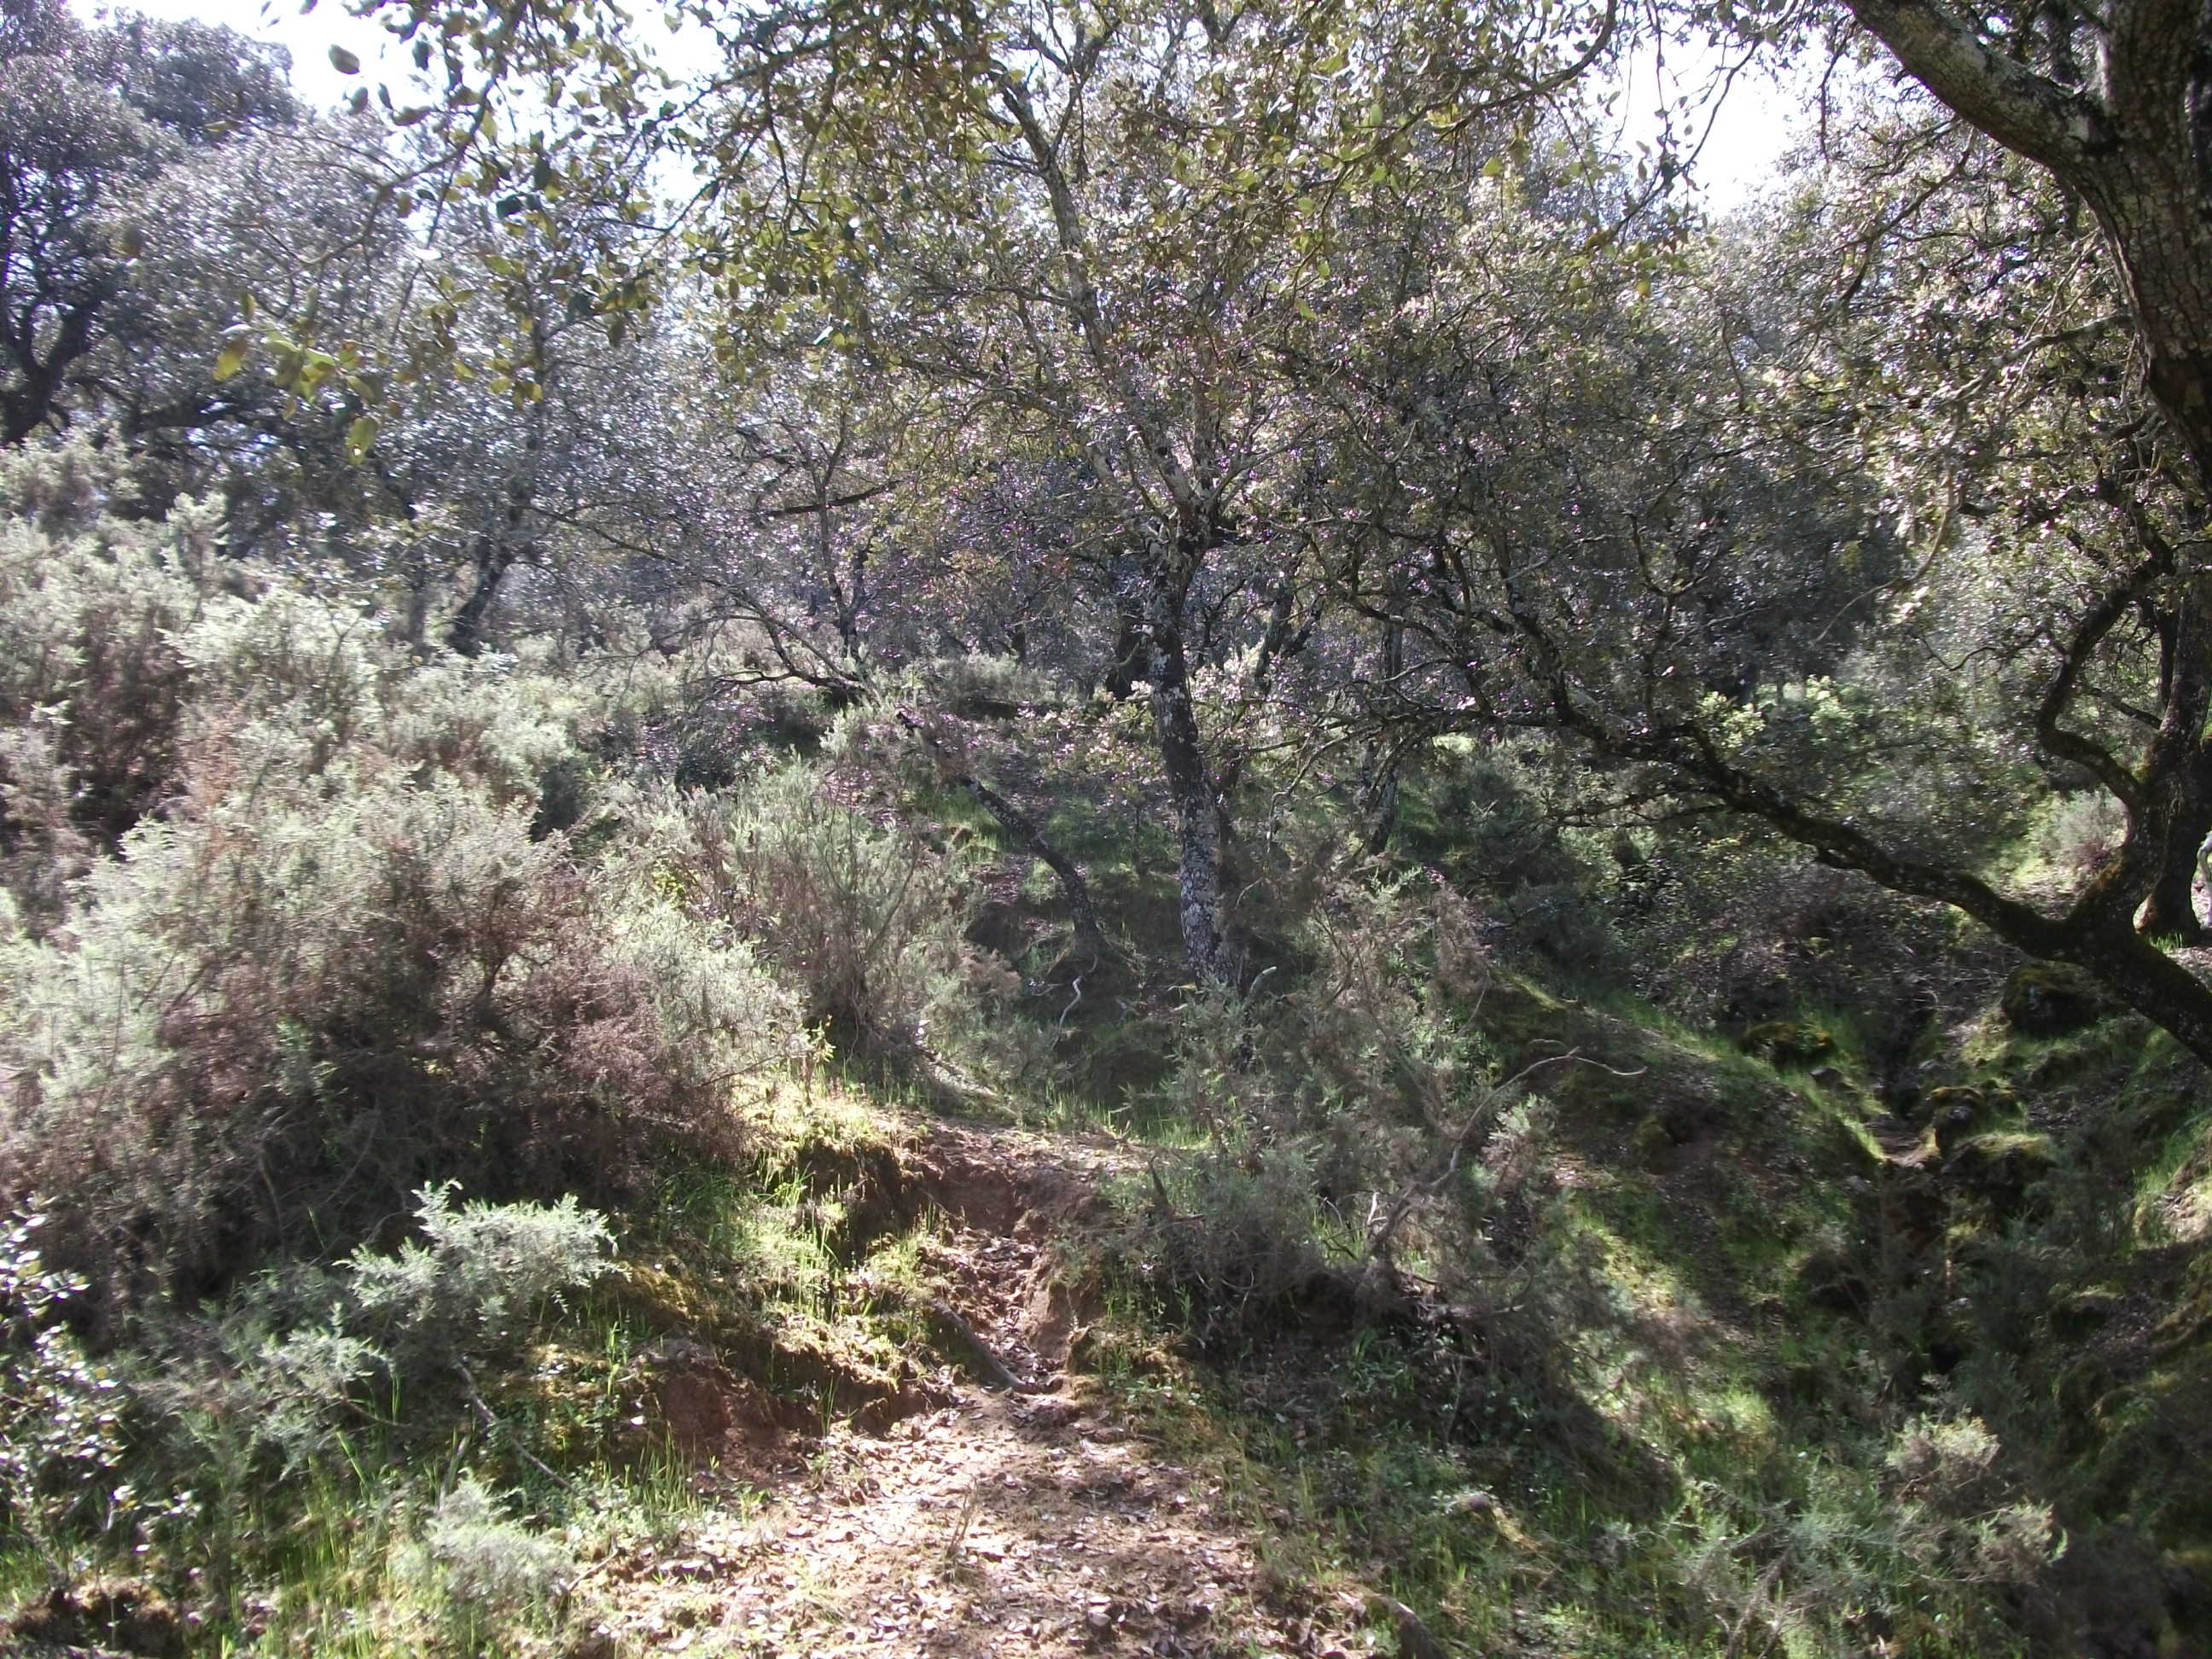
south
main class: Woodland
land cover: Broadleaved woodland
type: broadleaved evergreen forest
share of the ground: 50 - 75 %
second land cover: Shrubland without tree cover
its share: 50 - 75 %
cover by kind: broadleaved forest trees 60 %, shrubs 35 %, herbaceous plants 5 %
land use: Forestry
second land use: Agriculture (excluding fallow land and kitchen gardens)
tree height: > 5 m
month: April
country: ES
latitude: 37.9639
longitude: -6.7694
